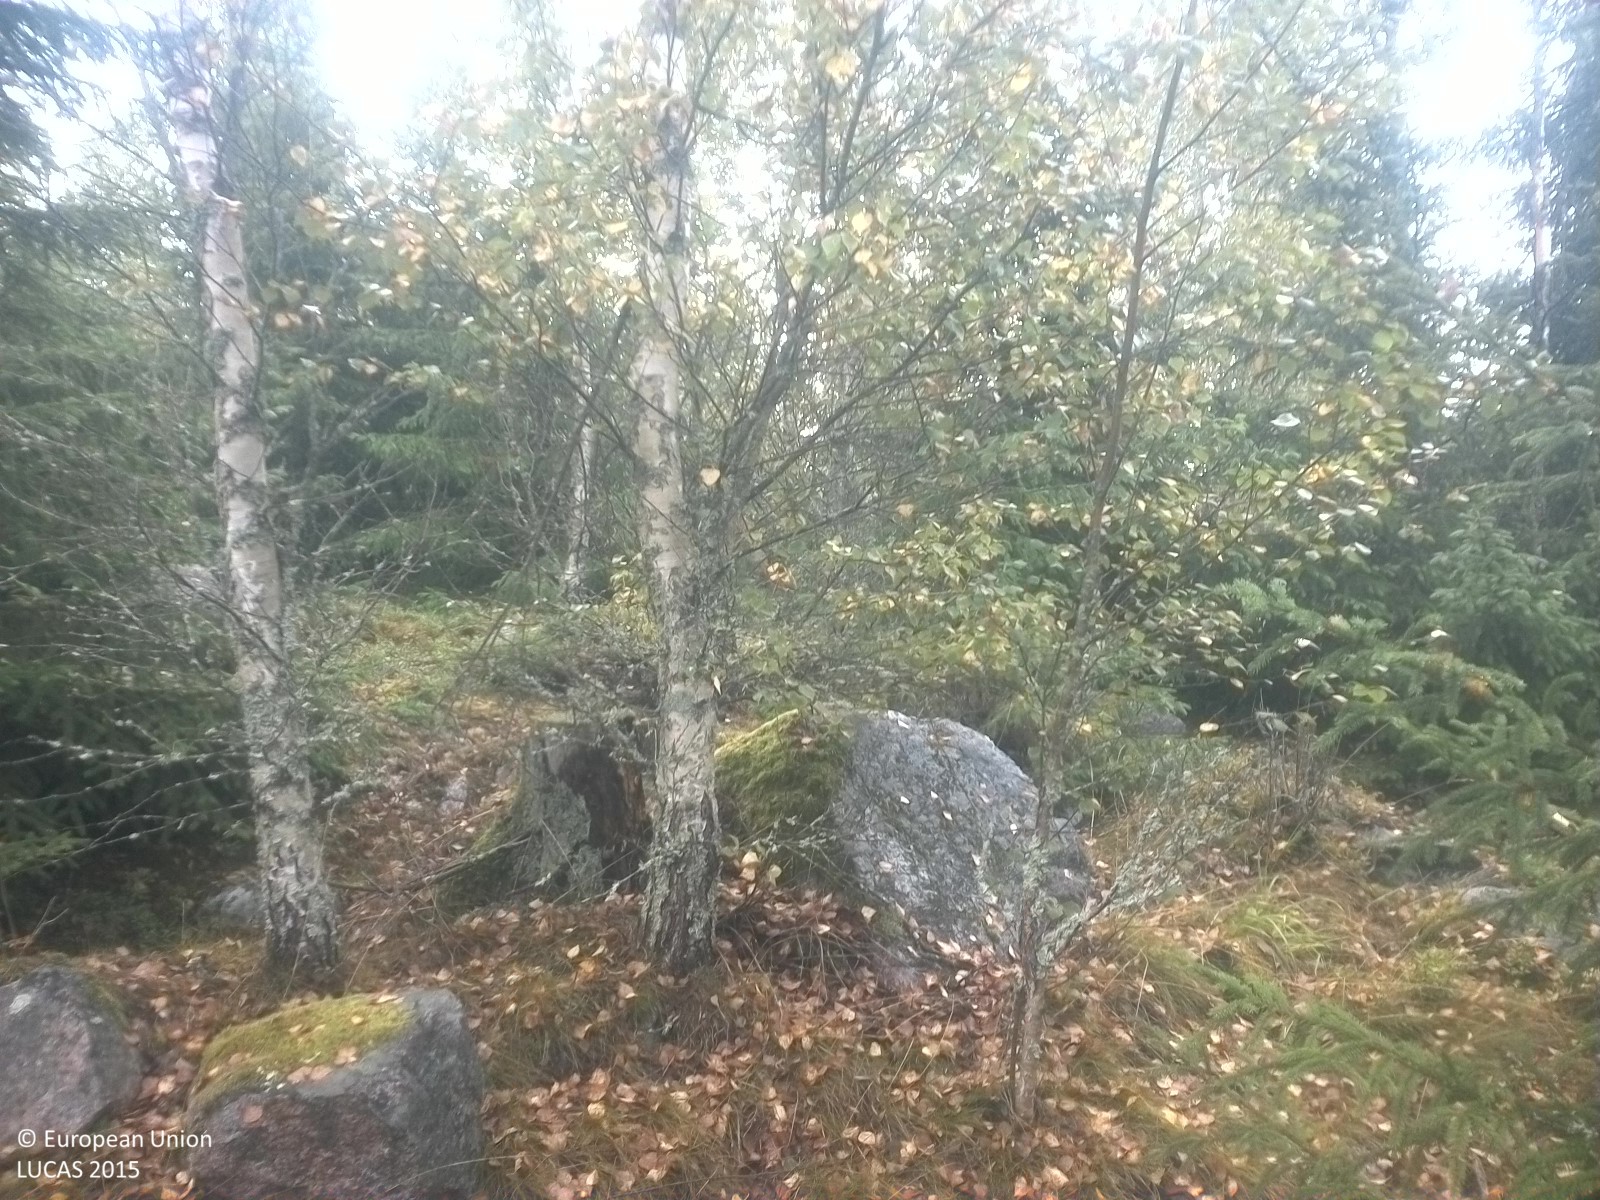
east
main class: Woodland
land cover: Other mixed woodland
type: boreal forest
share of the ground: 25 - 50 %
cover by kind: herbaceous plants 40 %, coniferous forest trees 25 %, lichens and mosses 20 %, broadleaved forest trees 15 %
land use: Forestry
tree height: < 5 m
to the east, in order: Other mixed woodland; Spruce dominated mixed woodland; Ditches and canals; Oats
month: September
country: SE
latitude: 59.3461
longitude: 15.6363
